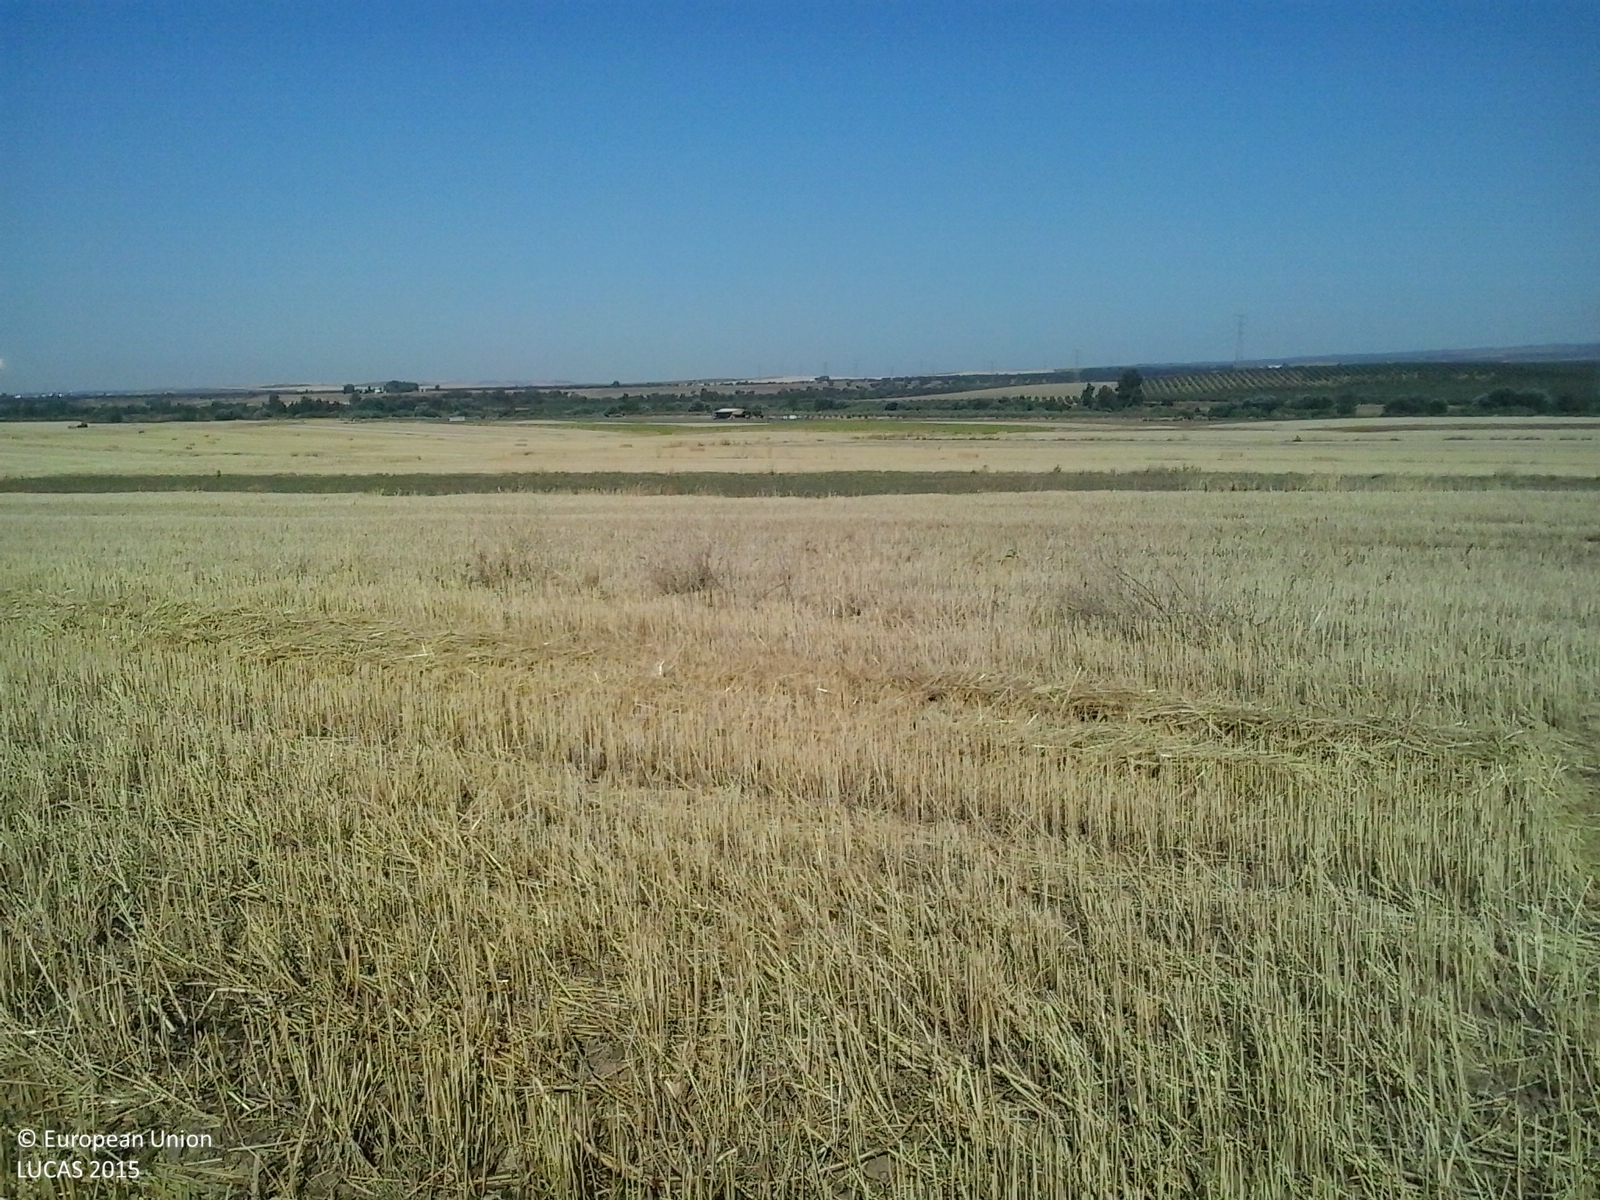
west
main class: Cropland
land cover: Common wheat
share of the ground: < 10 %
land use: Agriculture (excluding fallow land and kitchen gardens)
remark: Harvested field
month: June
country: ES
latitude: 37.4758
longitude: -6.1876
